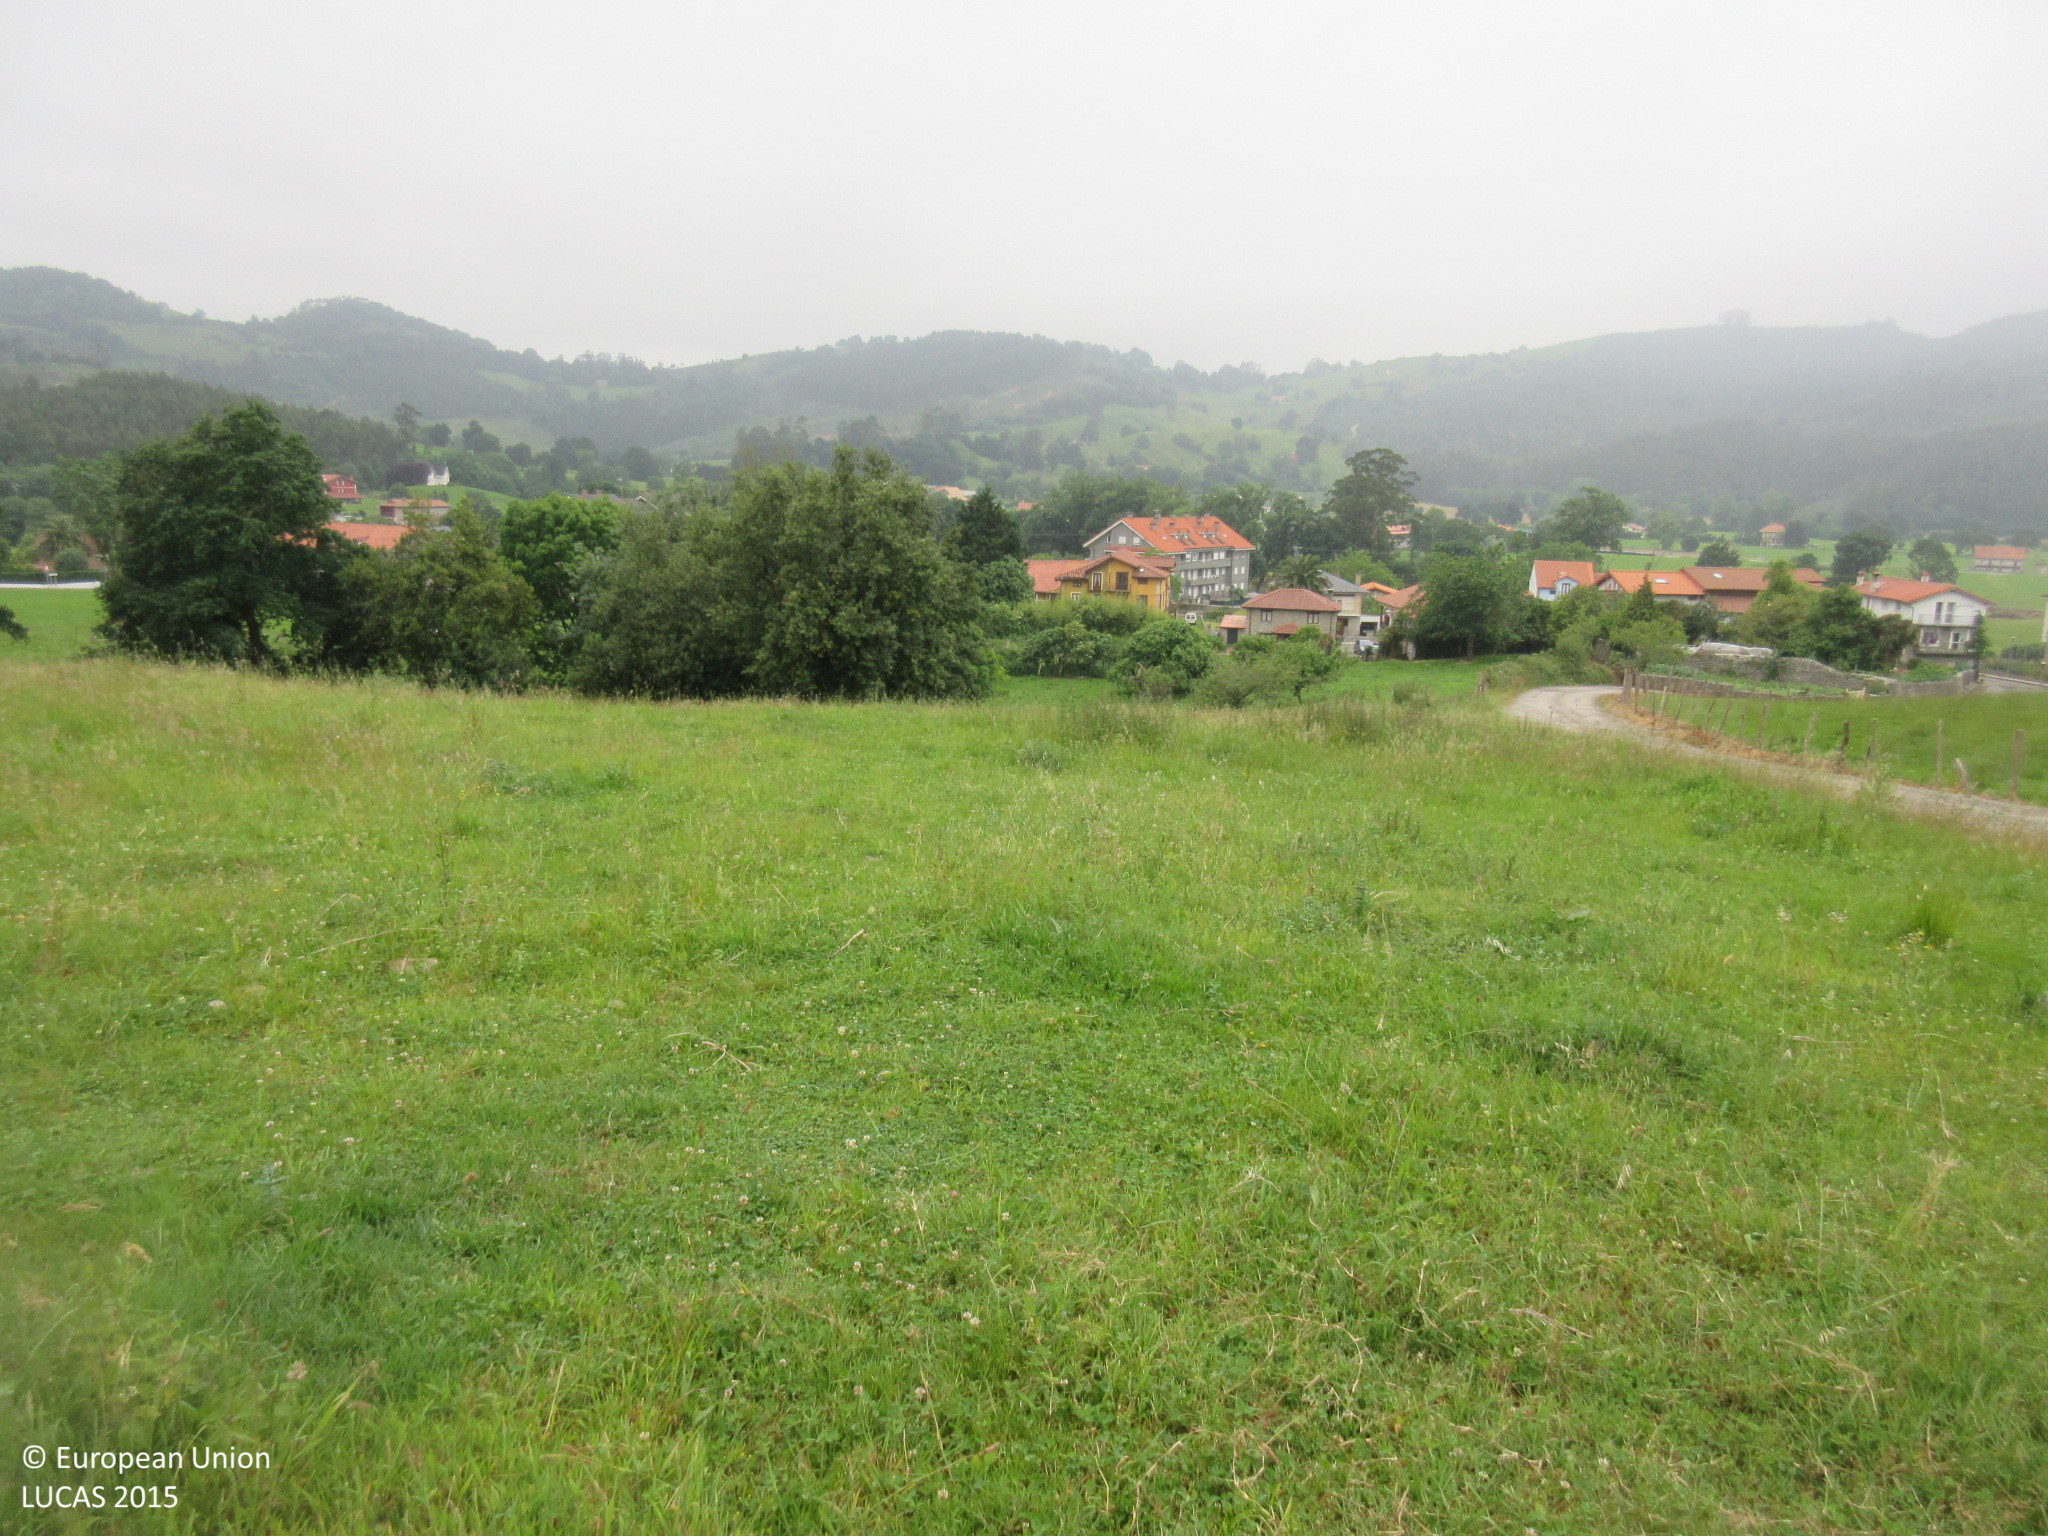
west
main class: Grassland
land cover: Grassland without tree/shrub cover
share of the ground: > 75 %
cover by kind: herbaceous plants 100 %
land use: Agriculture (excluding fallow land and kitchen gardens)
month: June
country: ES
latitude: 43.3793
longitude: -3.5850
